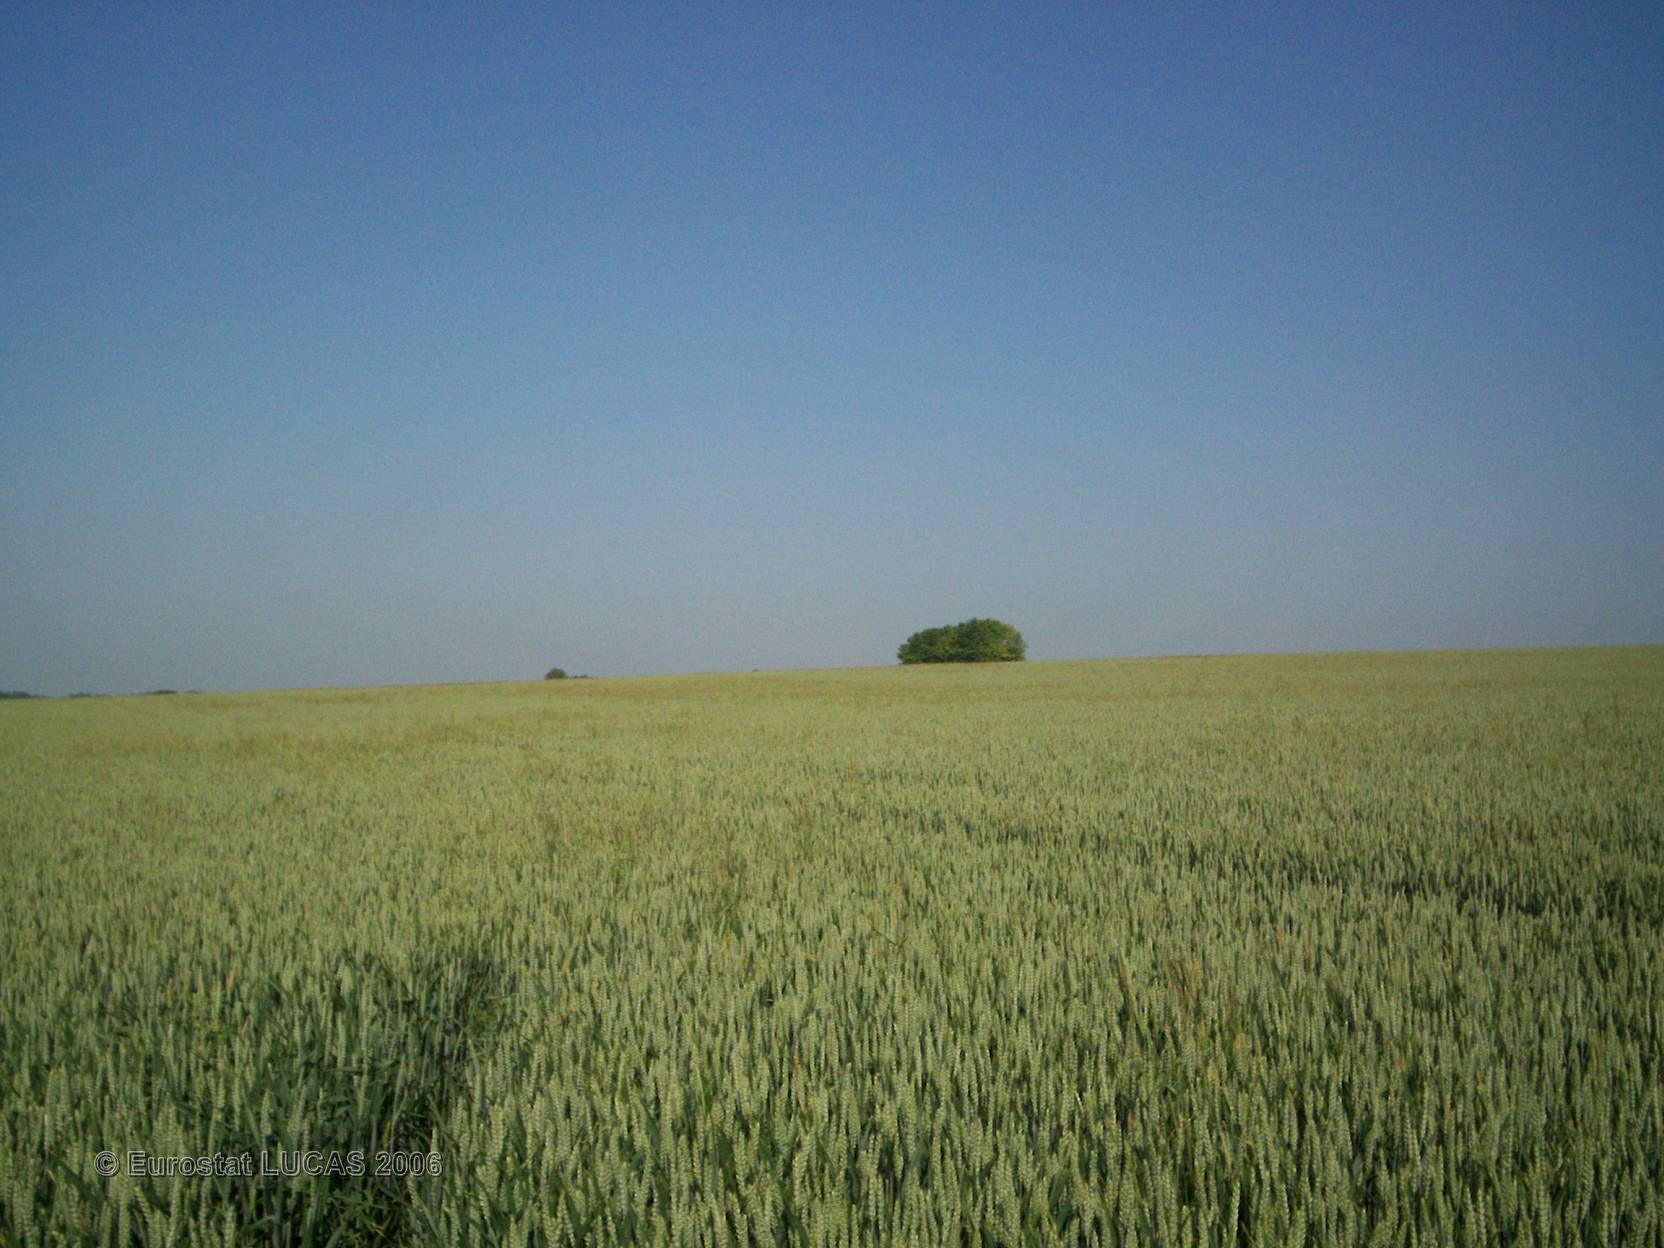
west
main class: Cropland
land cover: Common wheat
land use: Agriculture (excluding fallow land and kitchen gardens)
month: June
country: FR
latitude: 49.4959
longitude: 2.6574
